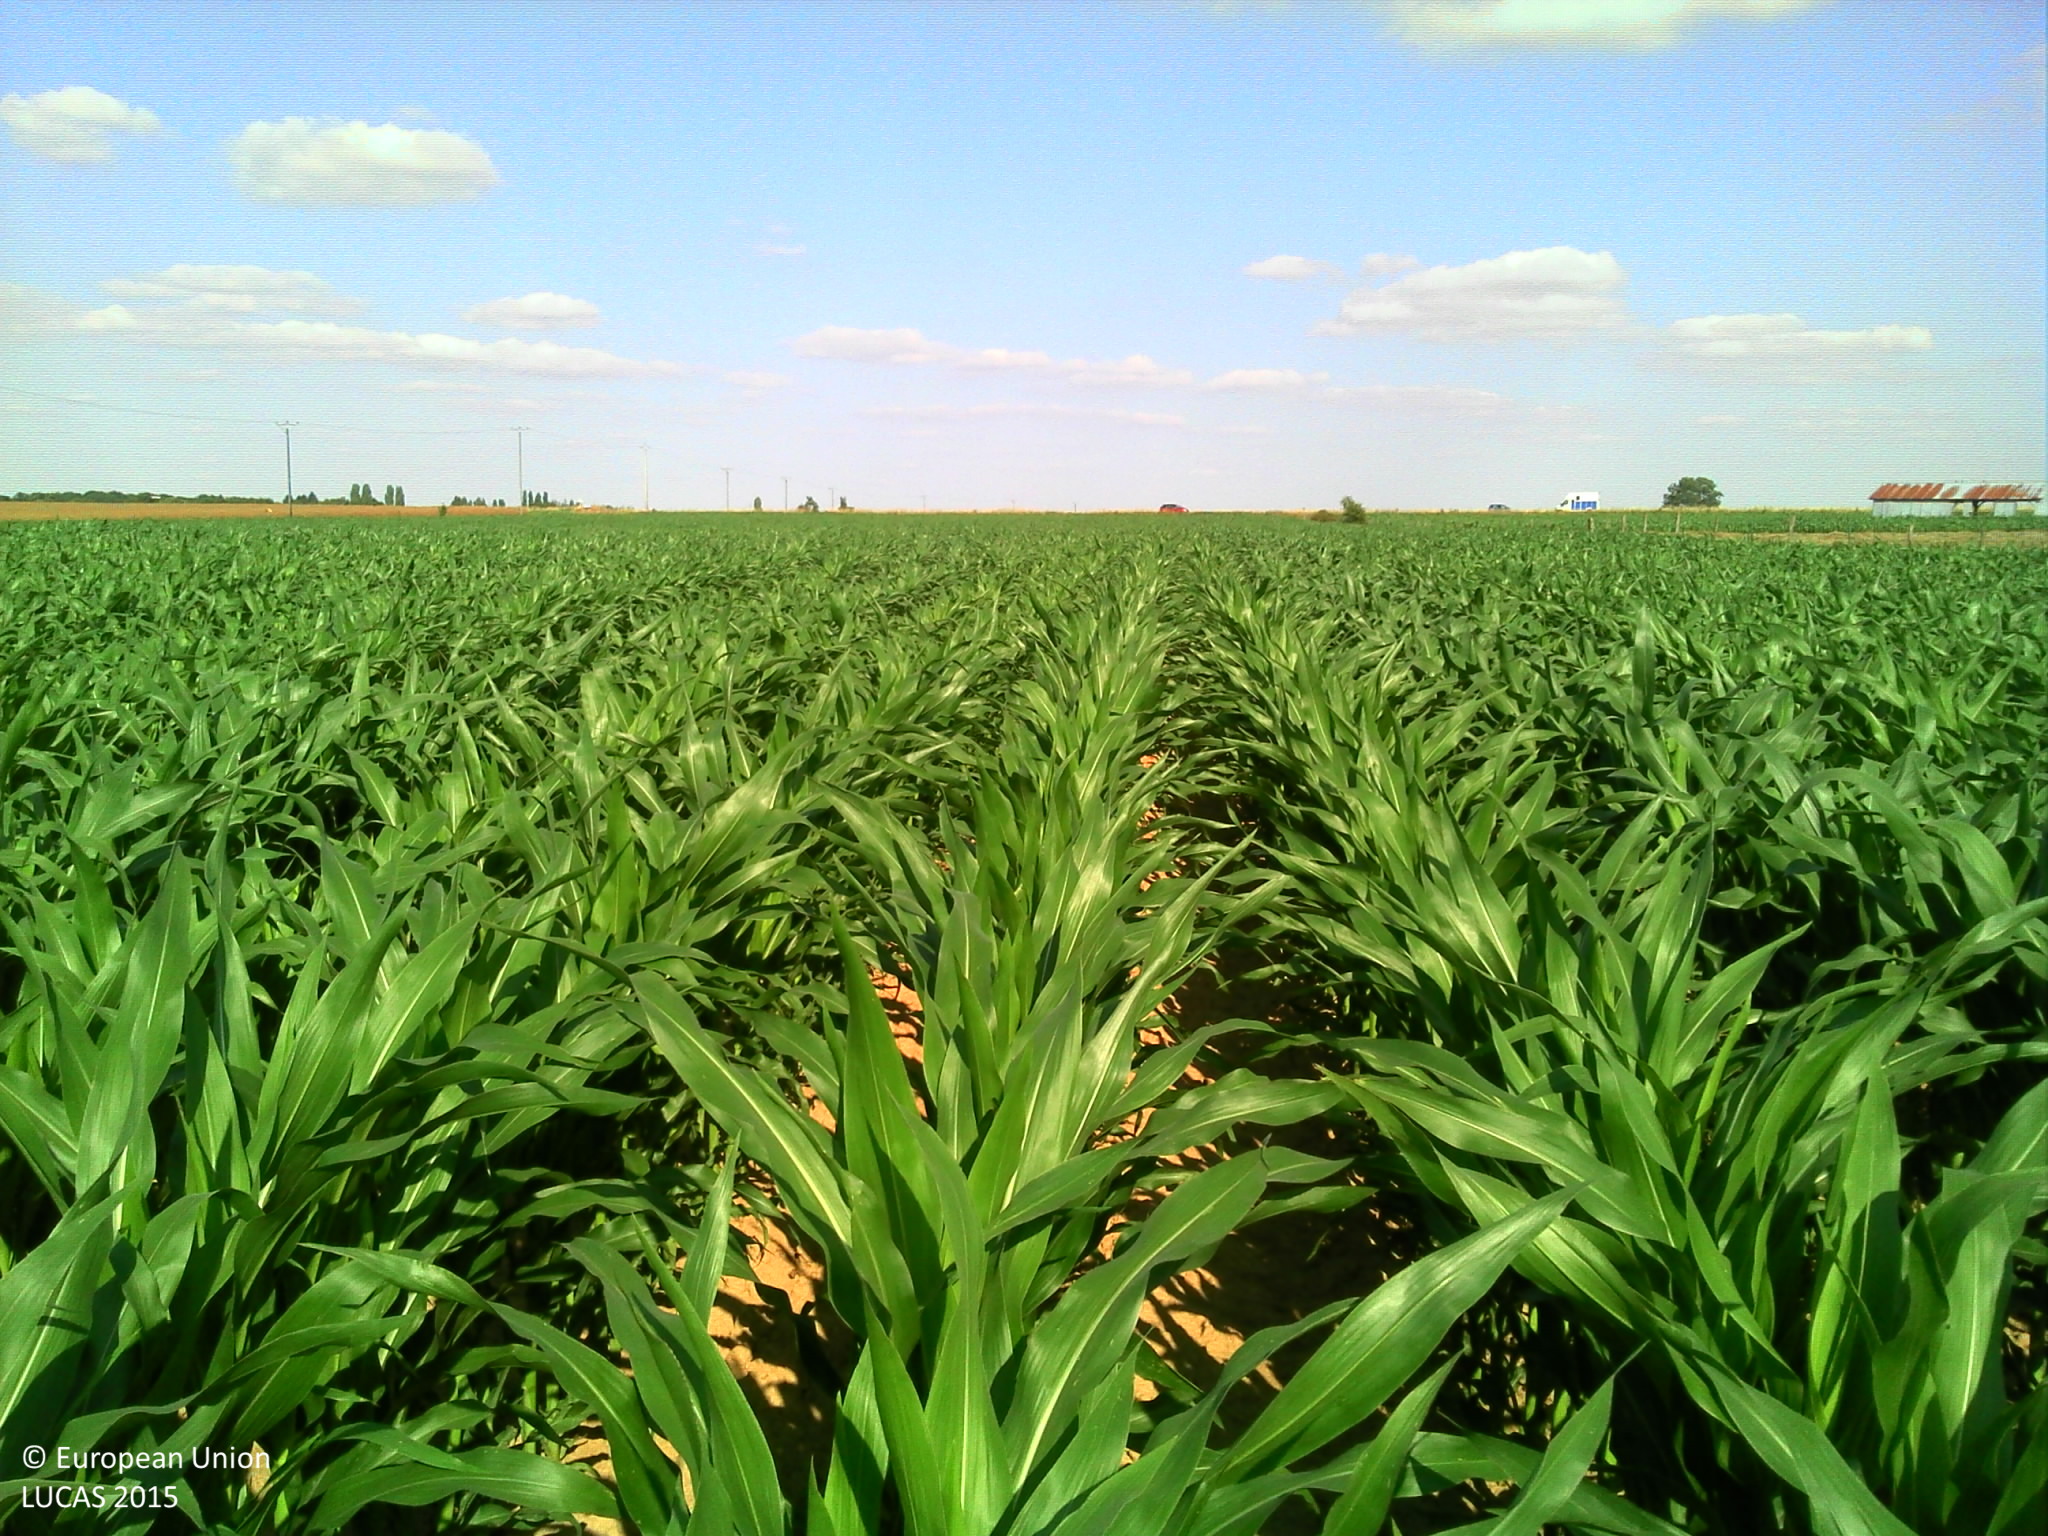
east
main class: Cropland
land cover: Maize
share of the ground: > 75 %
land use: Agriculture (excluding fallow land and kitchen gardens)
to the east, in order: Maize
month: July
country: FR
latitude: 49.1689
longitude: 0.6902
